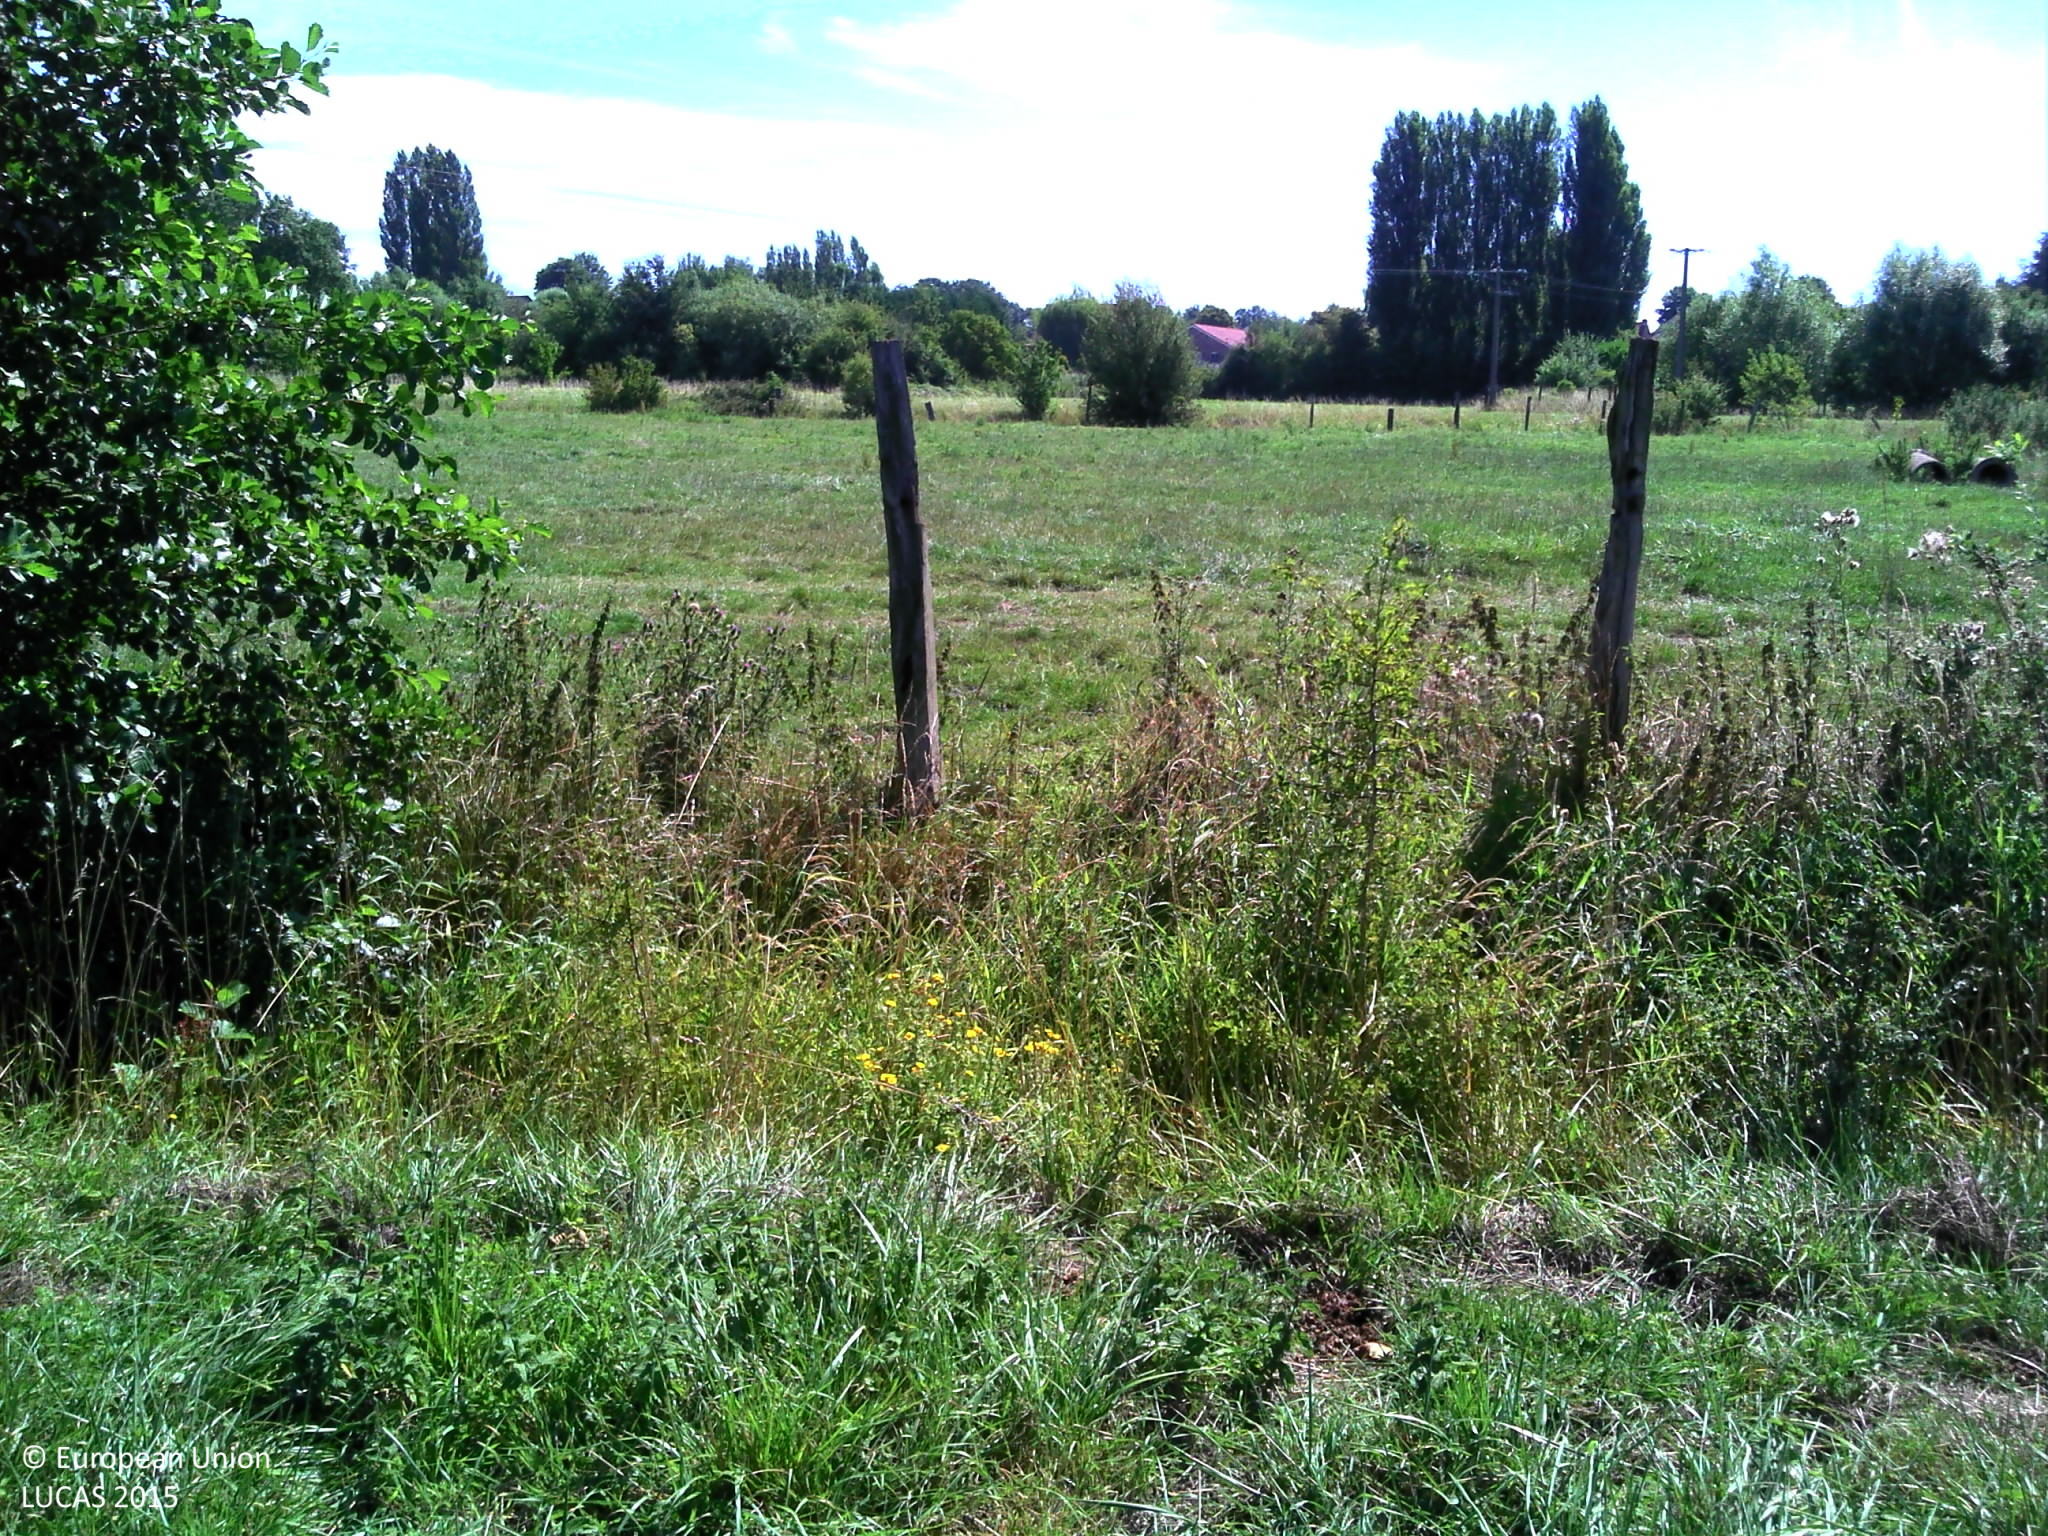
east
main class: Grassland
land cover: Grassland without tree/shrub cover
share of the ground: > 75 %
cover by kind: herbaceous plants 95 %, lichens and mosses 5 %
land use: Agriculture (excluding fallow land and kitchen gardens)
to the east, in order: Grassland without tree/shrub cover; Fences; Ditches and canals; Grassland without tree/shrub cover; Ditches and canals; Grassland without tree/shrub cover; Abandoned hedges; Grassland without tree/shrub cover; Abandoned hedges; Maize
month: August
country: FR
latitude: 50.3586
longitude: 3.1736
